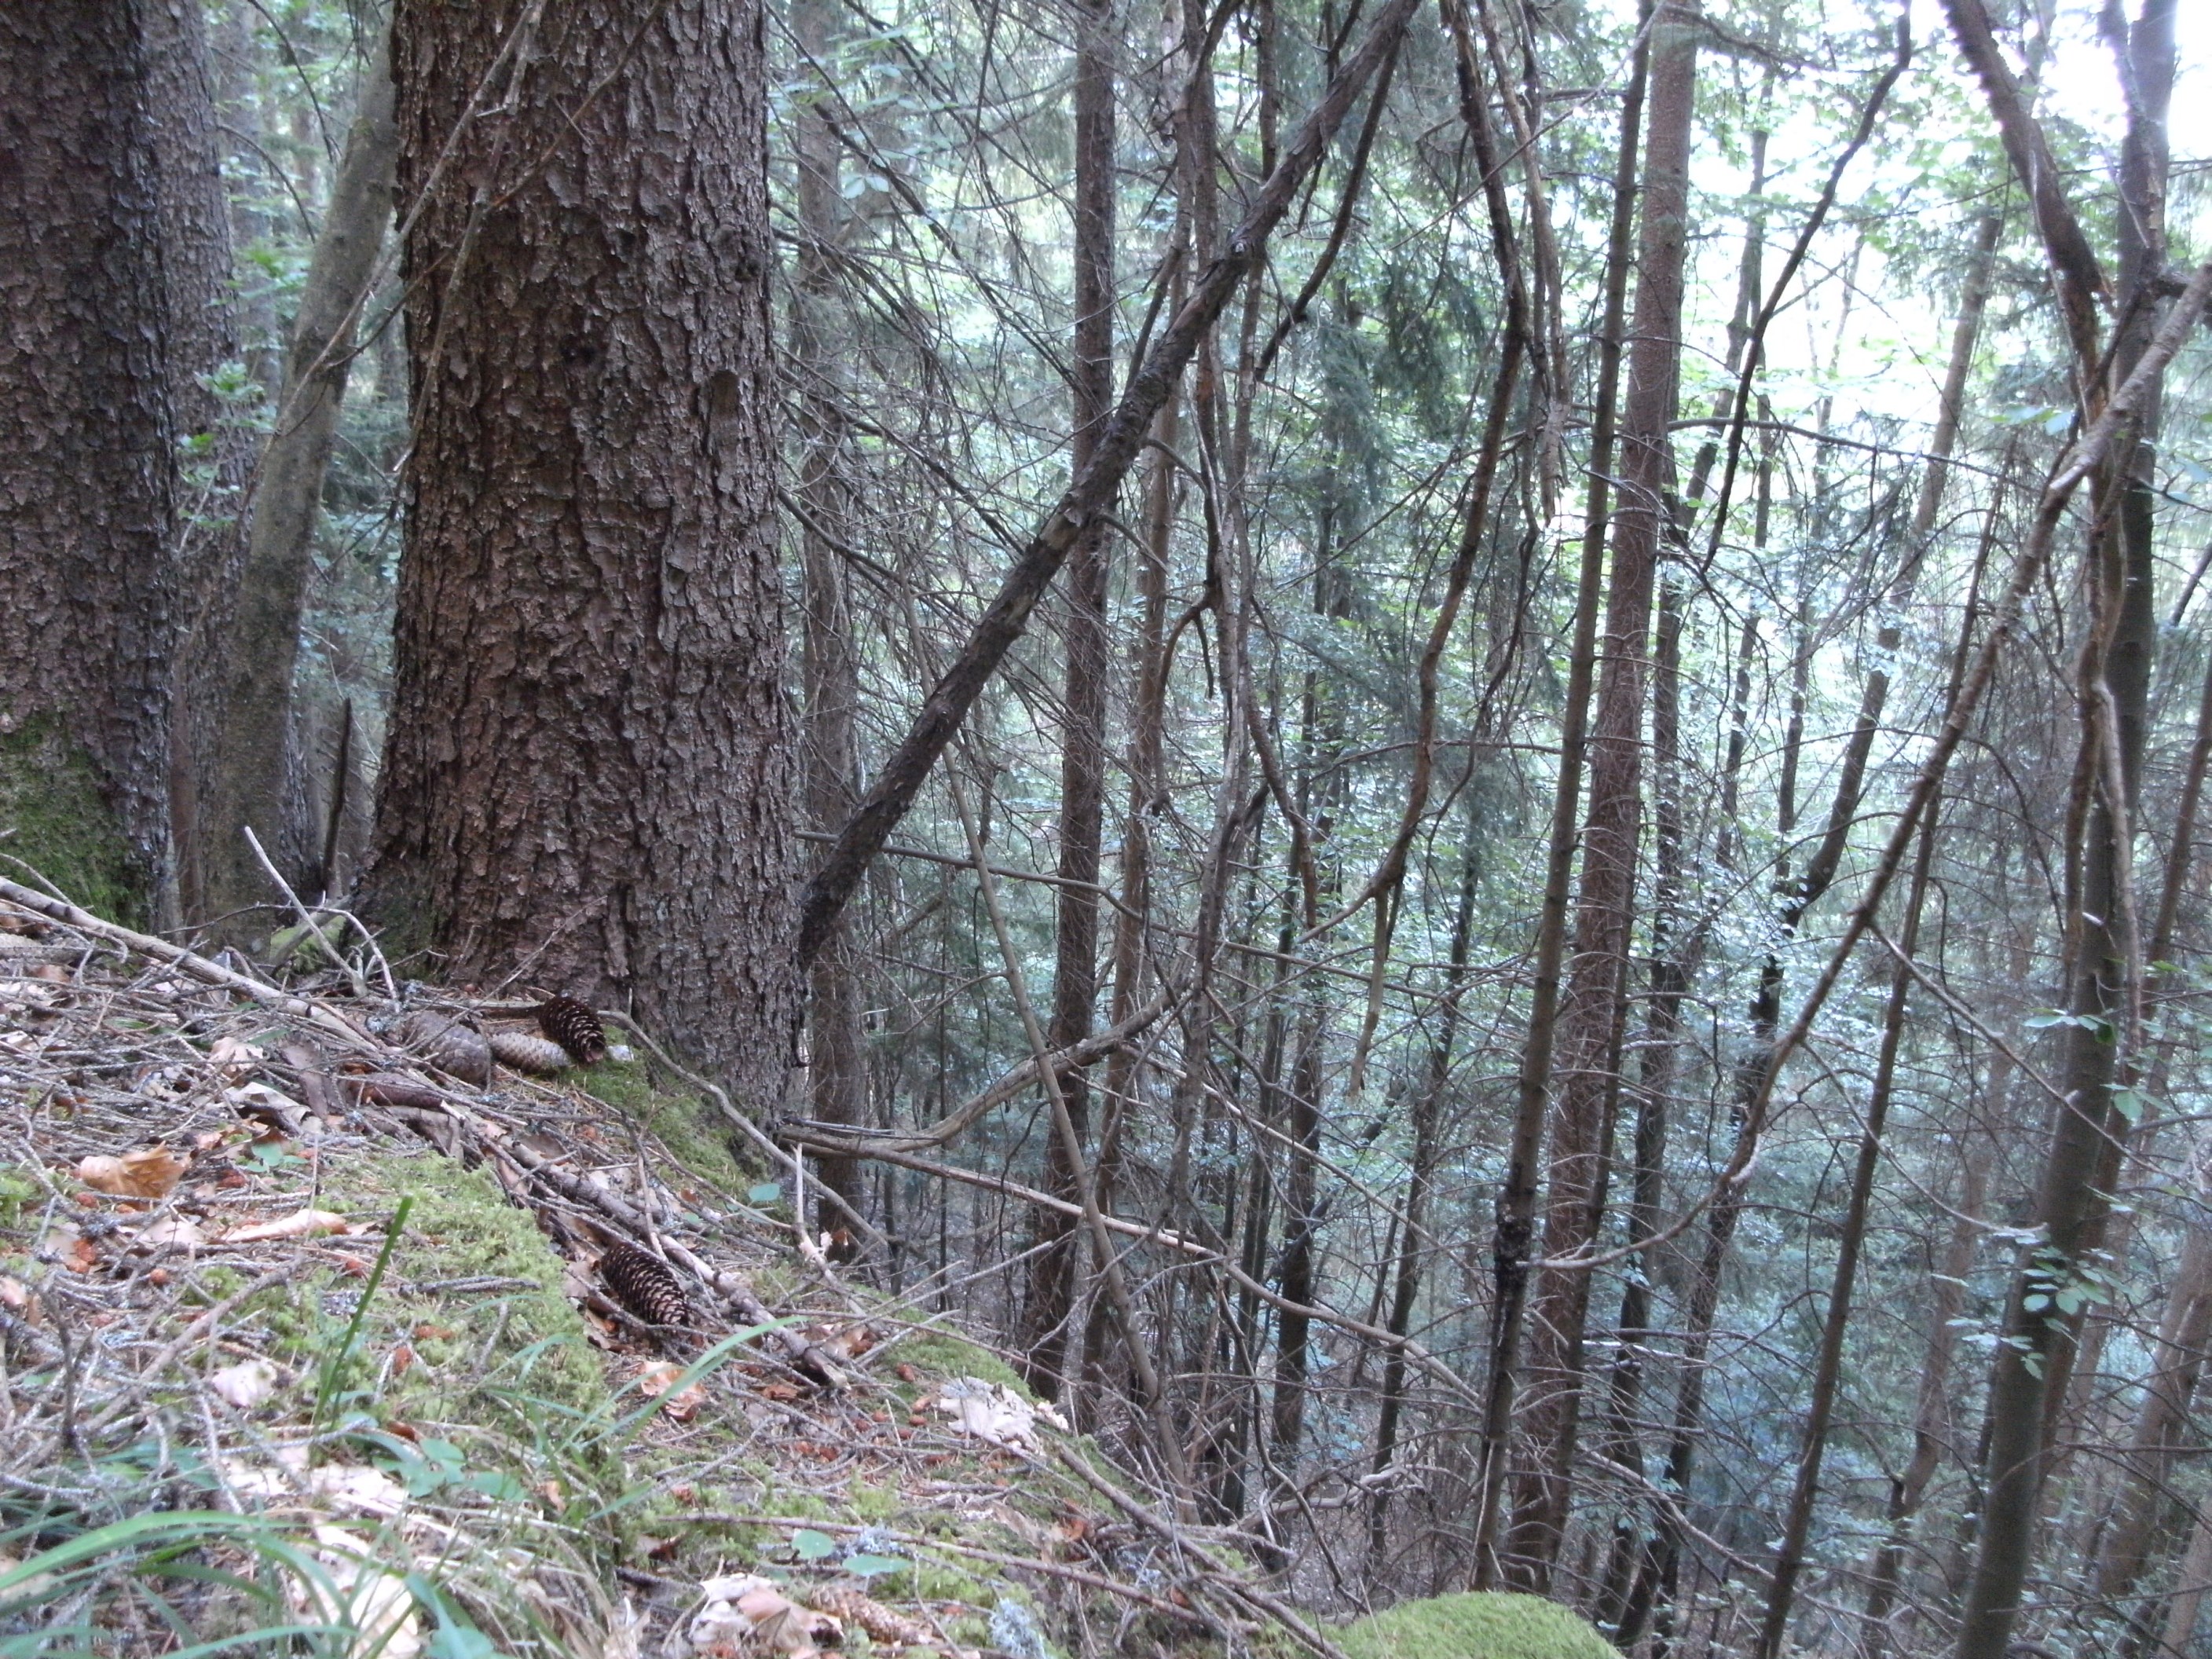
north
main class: Woodland
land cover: Spruce dominated coniferous woodland
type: hemiboreal forest and nemoral coniferous forest and mixed broadleaved-coniferous forest
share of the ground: > 75 %
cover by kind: coniferous forest trees 65 %, broadleaved forest trees 20 %, unconsolidated bare surface 10 %, lichens and mosses 5 %
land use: Forestry
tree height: > 5 m
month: July
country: AT
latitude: 46.5375
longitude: 14.6787
